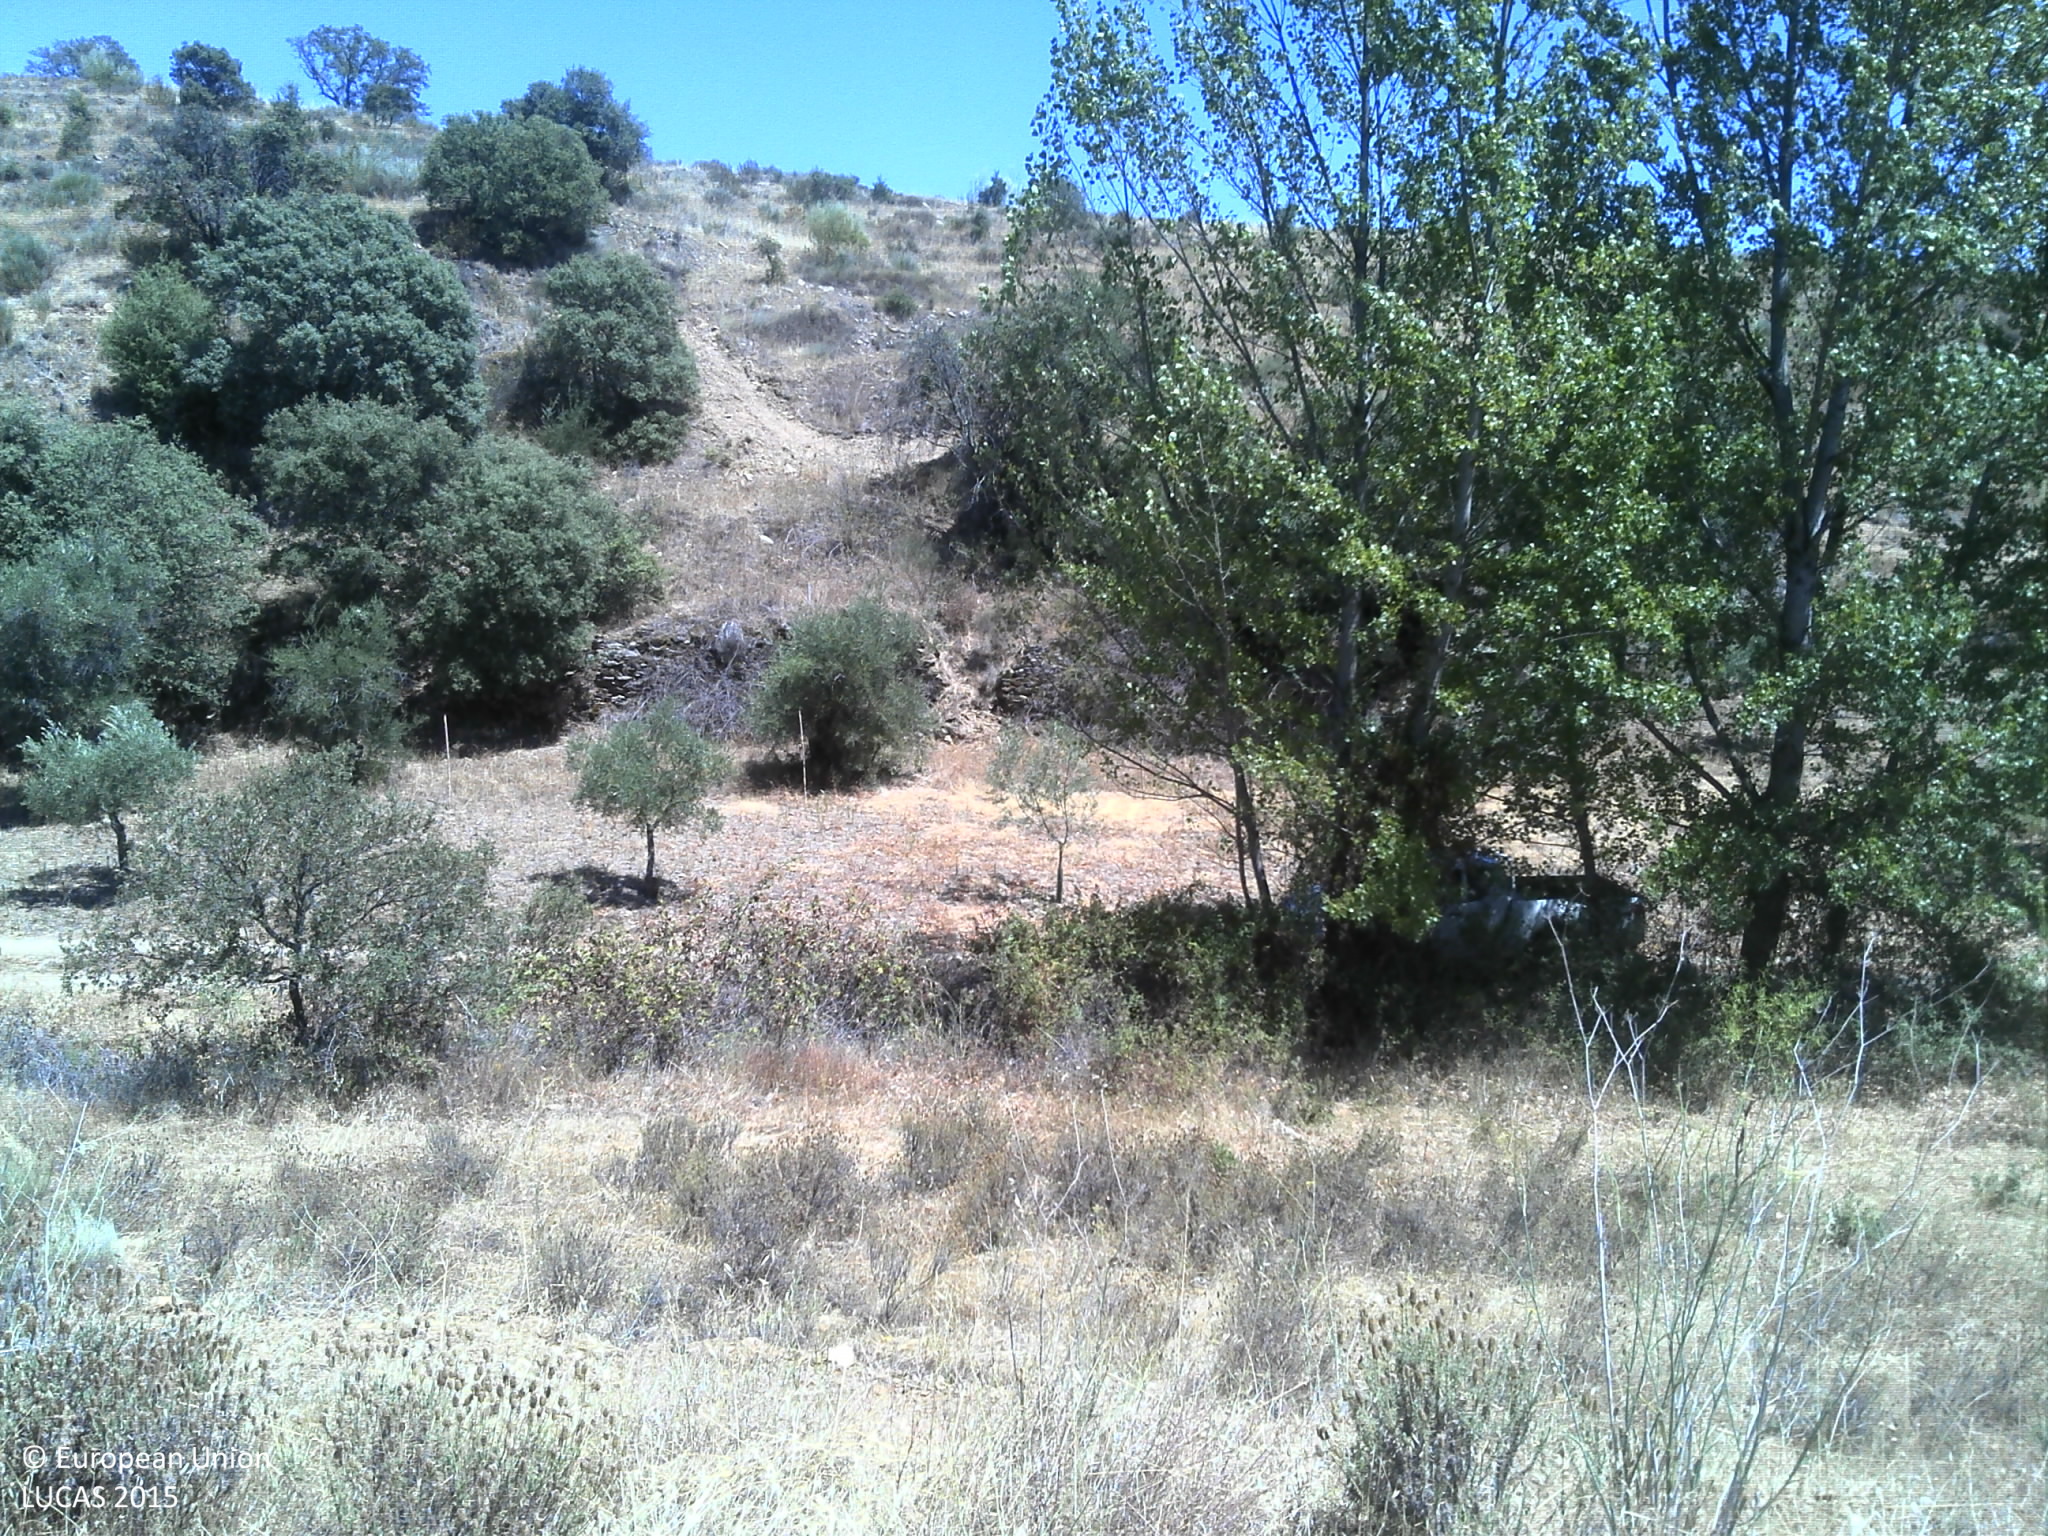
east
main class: Shrubland
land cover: Shrubland with sparse tree cover
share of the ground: > 75 %
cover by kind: shrubs 65 %, unconsolidated bare surface 20 %, herbaceous plants 10 %, broadleaved forest trees 5 %
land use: Abandoned areas
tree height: > 5 m
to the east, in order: Shrubland with sparse tree cover; Nuts trees; Shruby margins; Abandoned hedges; Rivers and streams; Grass margins; Tracks; Olive groves; Dry stone walls; Broadleaved woodland; Grassland with sparse tree/shrub cover; Shrubland without tree cover; Tracks; Shrubland with sparse tree cover; Tracks; Broadleaved woodland
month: July
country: PT
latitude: 41.3652
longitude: -7.0291
